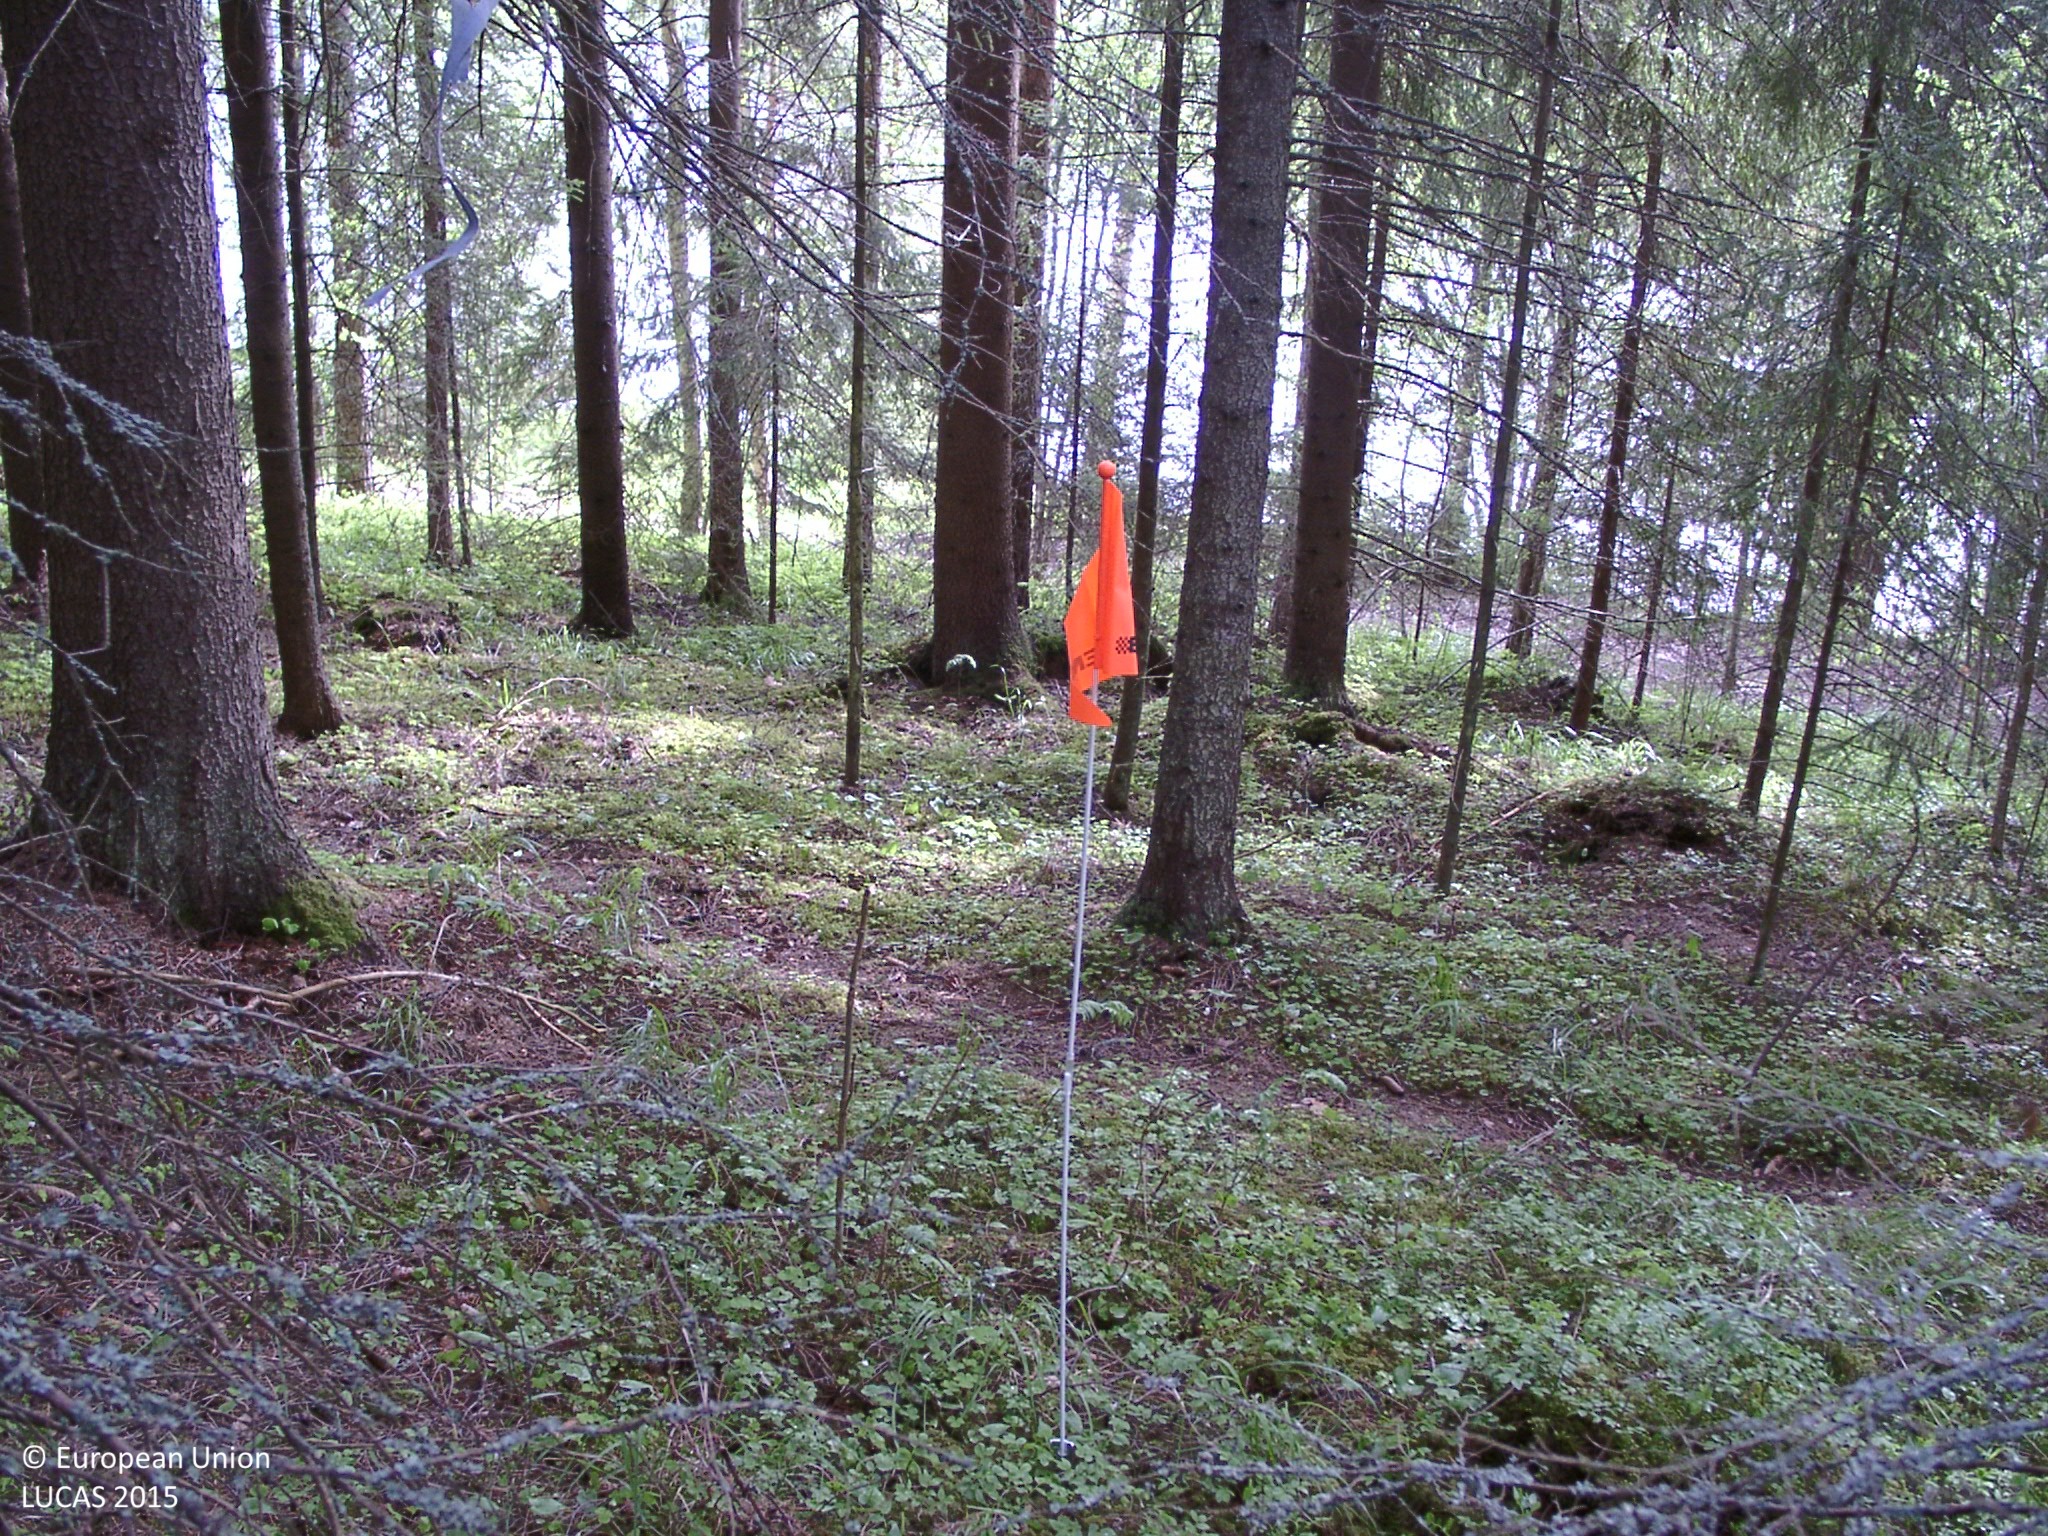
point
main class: Woodland
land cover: Spruce dominated coniferous woodland
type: boreal forest
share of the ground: > 75 %
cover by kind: coniferous forest trees 80 %, herbaceous plants 10 %, broadleaved forest trees 5 %, lichens and mosses 5 %
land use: Forestry
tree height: > 5 m
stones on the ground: < 10 %
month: June
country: FI
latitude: 62.1677
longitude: 25.5329
